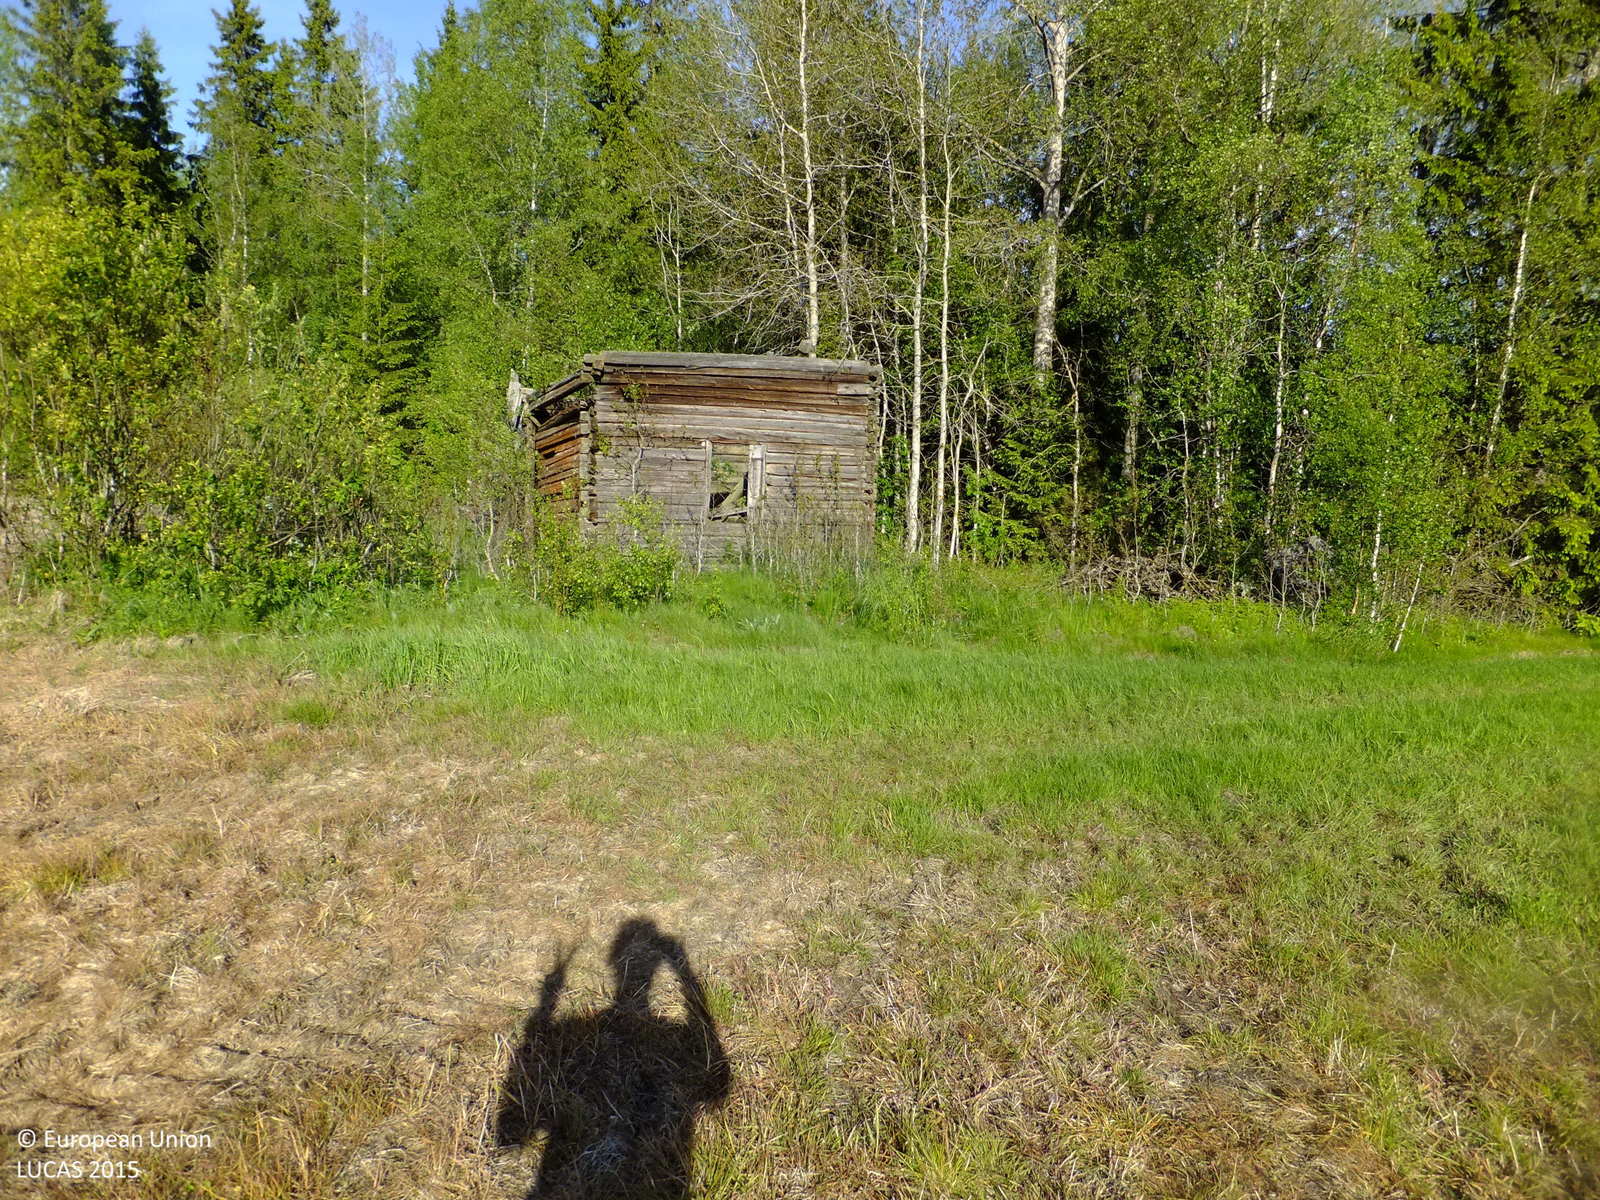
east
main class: Grassland
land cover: Grassland without tree/shrub cover
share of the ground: > 75 %
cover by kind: herbaceous plants 100 %
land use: Agriculture (excluding fallow land and kitchen gardens)
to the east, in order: Grassland without tree/shrub cover; Shrubland without tree cover; Artificial constructions in urban areas; Spruce dominated mixed woodland; Rivers and streams; Other bare soil; Grassland without tree/shrub cover; Pine dominated mixed woodland; Spruce dominated coniferous woodland
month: June
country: FI
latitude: 63.5050
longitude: 22.6464
